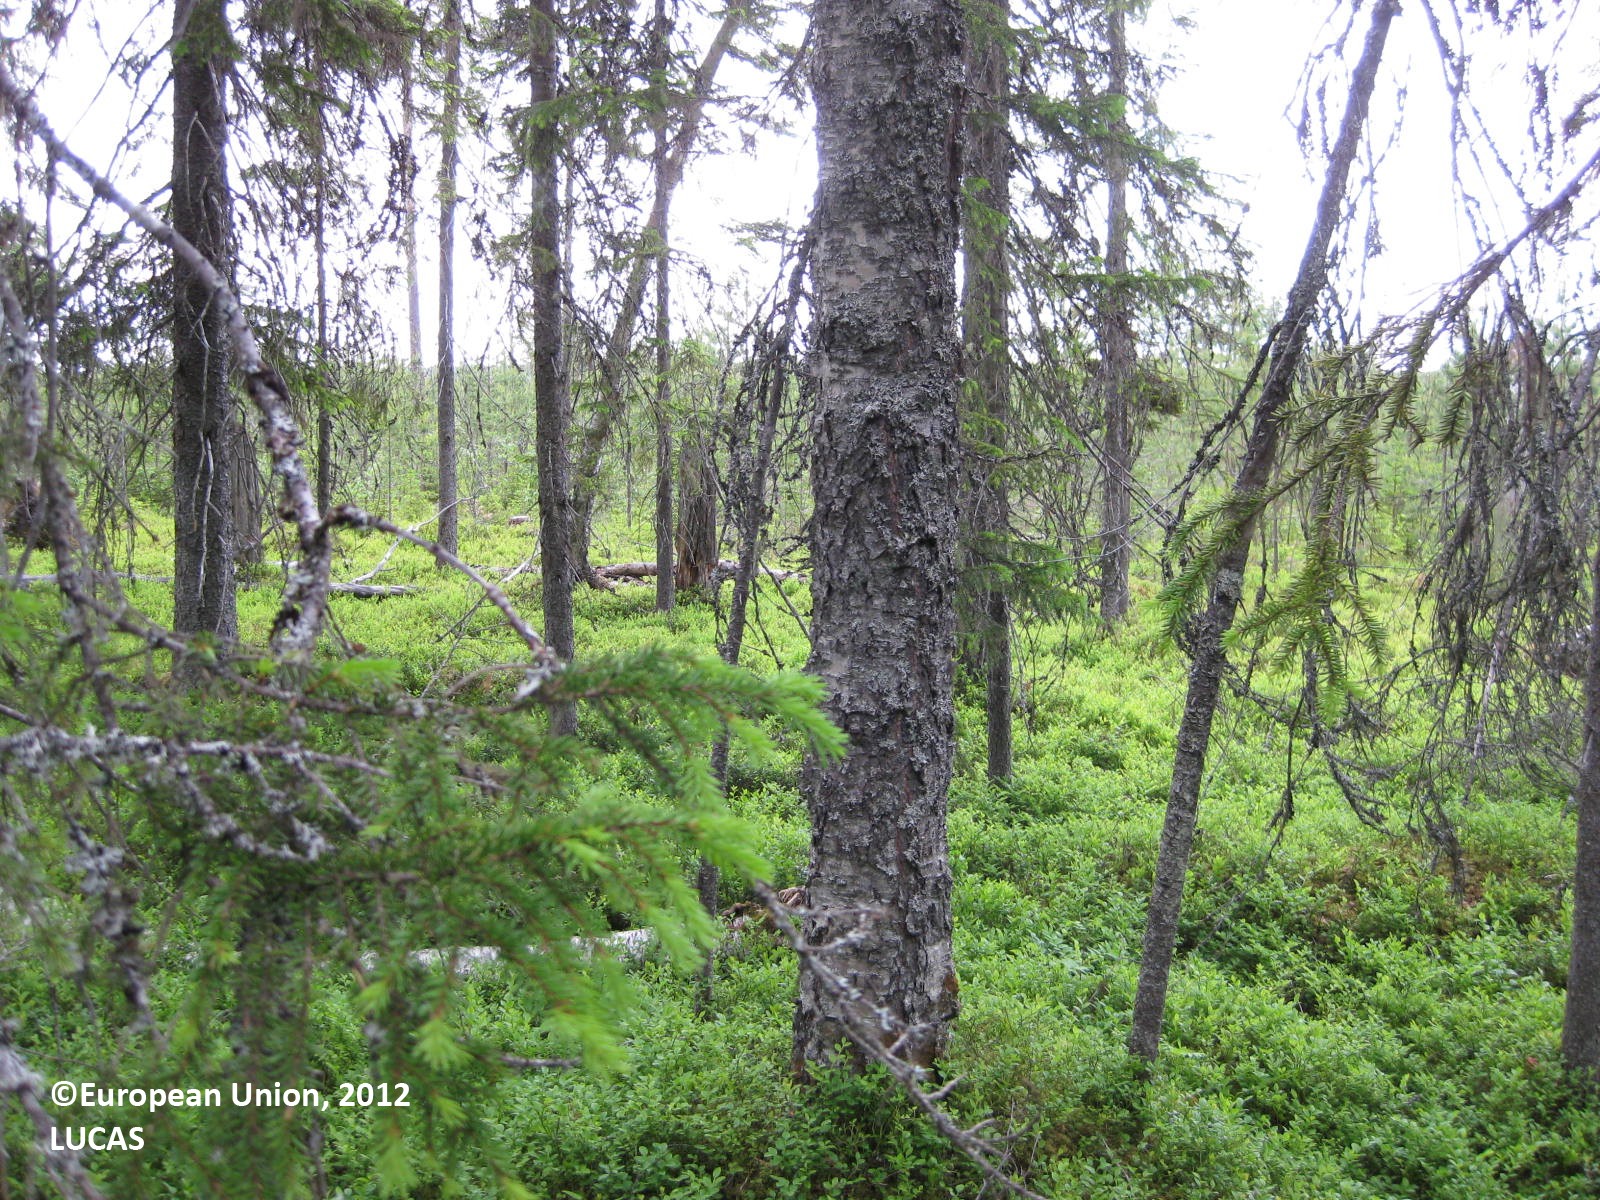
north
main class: Woodland
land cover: Other coniferous woodland
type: boreal forest
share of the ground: > 75 %
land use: Forestry
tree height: > 5 m
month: June
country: FI
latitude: 65.2877
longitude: 28.2272
